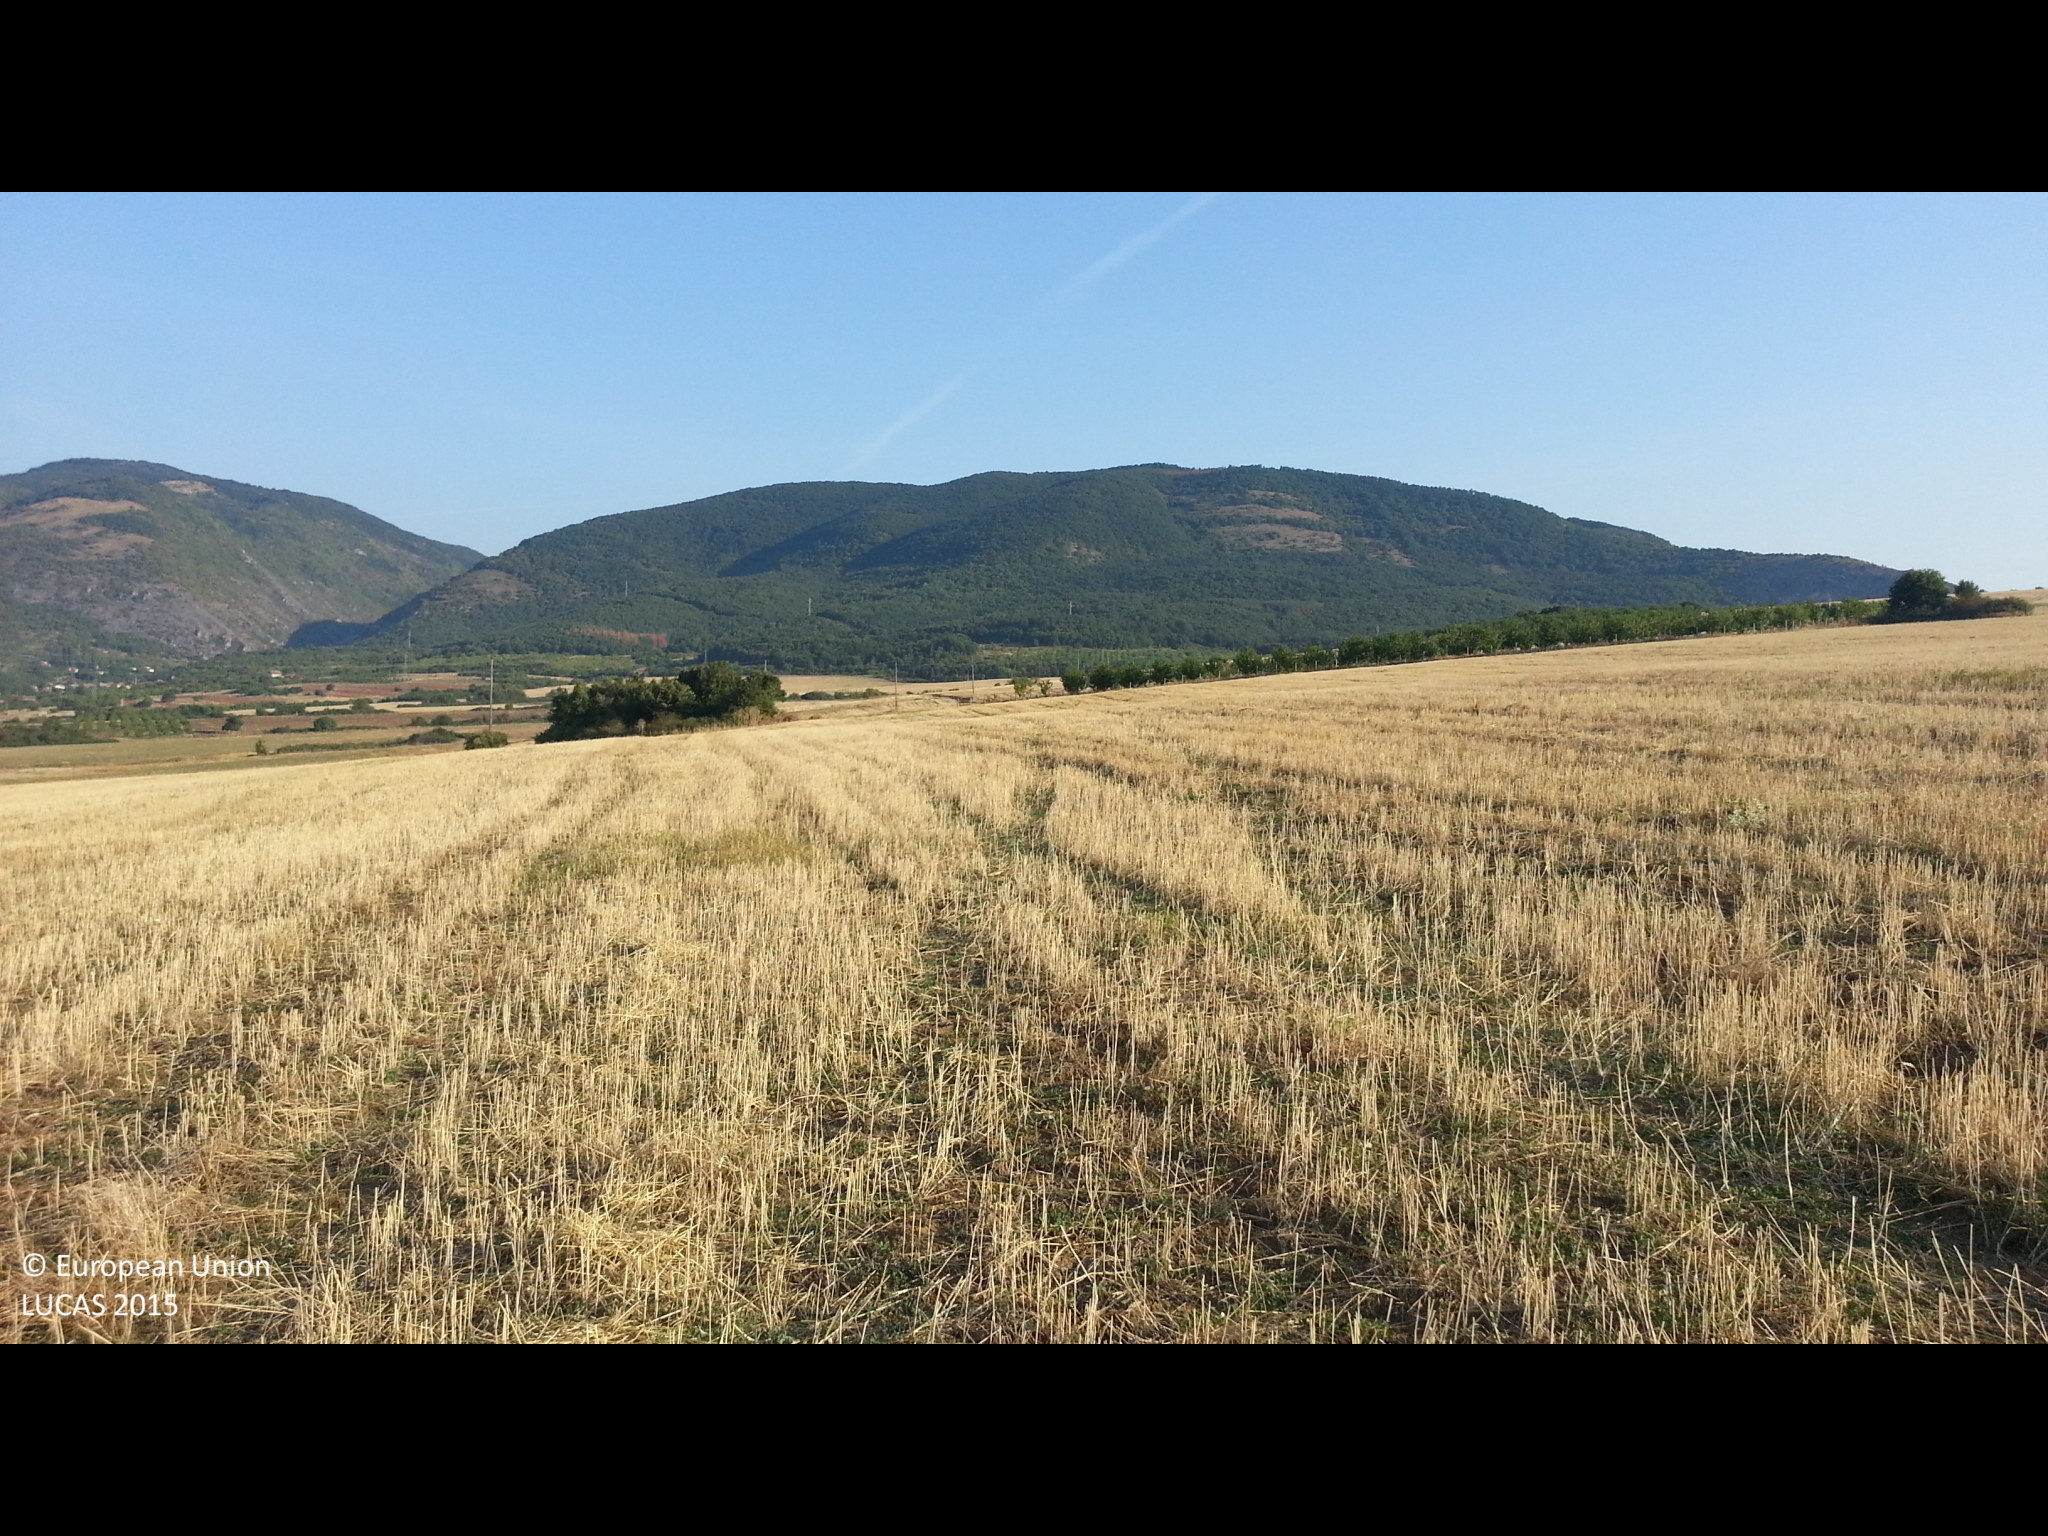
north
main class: Cropland
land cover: Common wheat
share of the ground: 50 - 75 %
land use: Agriculture (excluding fallow land and kitchen gardens)
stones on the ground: < 10 %
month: September
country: BG
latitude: 42.3156
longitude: 22.9223
